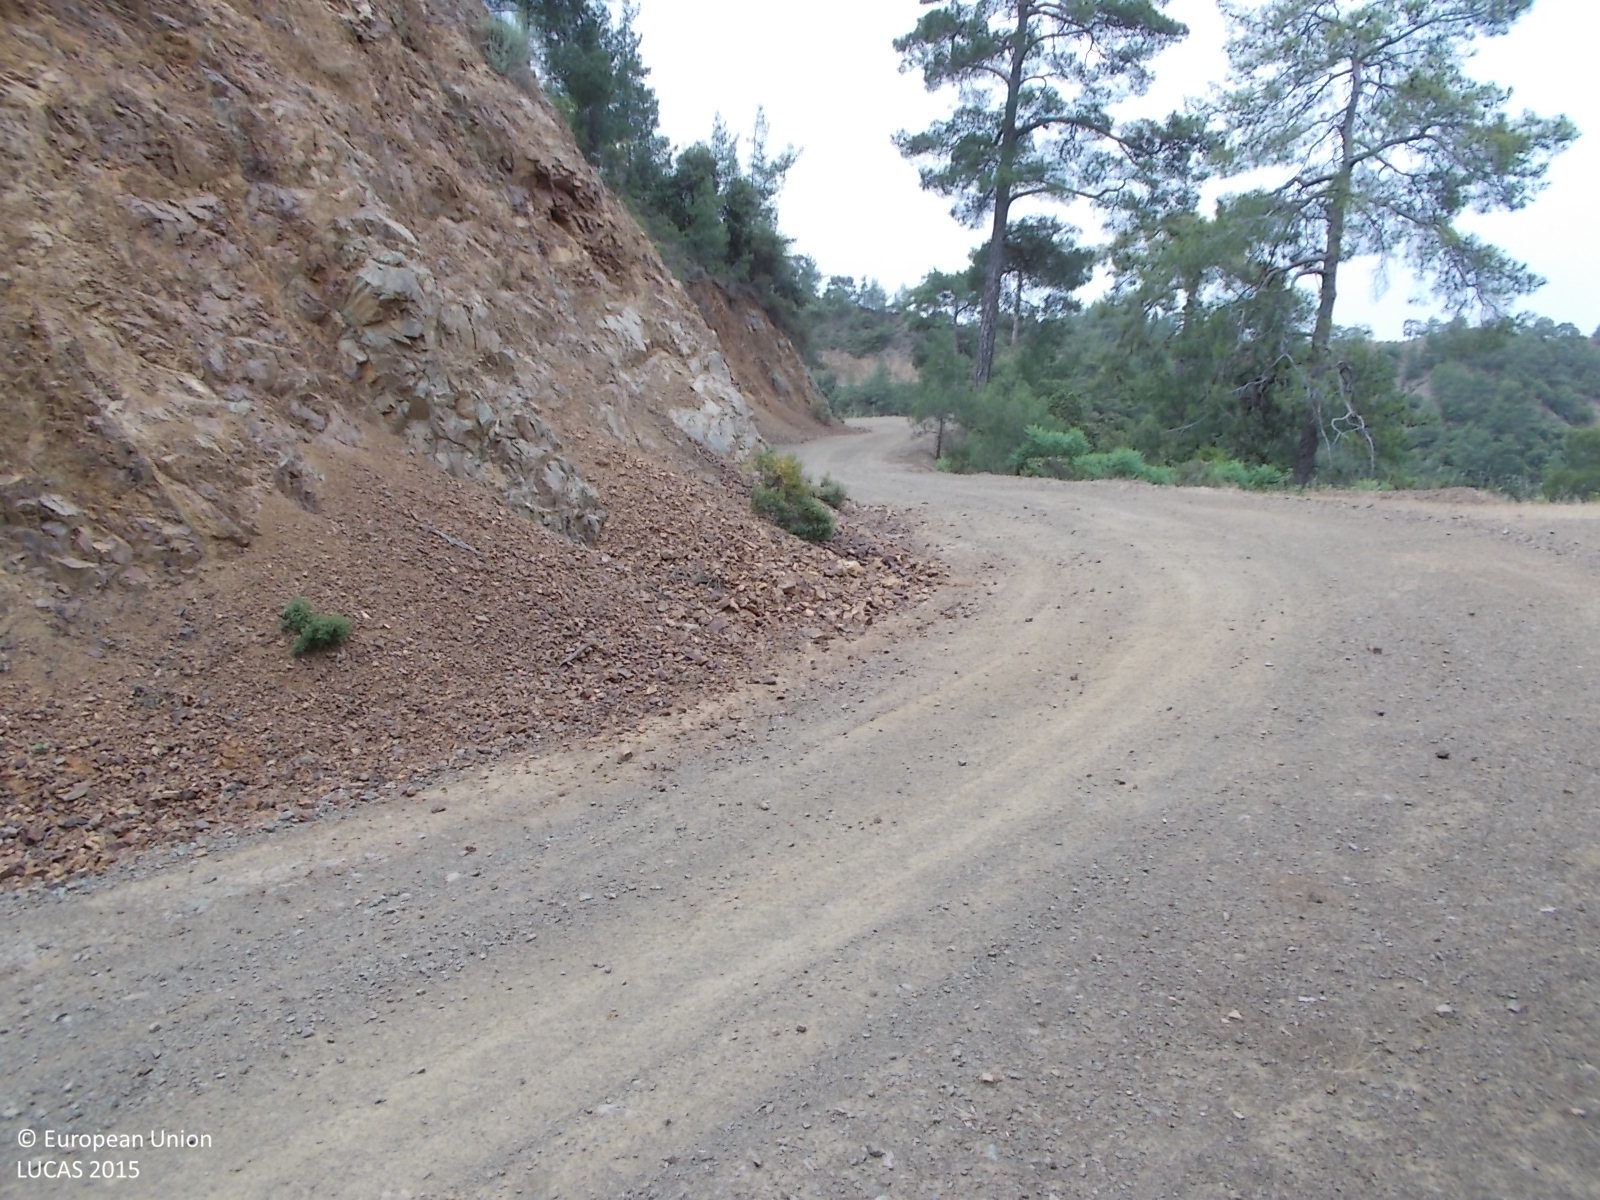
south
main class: Woodland
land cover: Broadleaved woodland
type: broadleaved evergreen forest
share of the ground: > 75 %
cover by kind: broadleaved forest trees 90 %, coniferous forest trees 10 %
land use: Forestry
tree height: > 5 m
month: May
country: CY
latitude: 34.9876
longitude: 32.6054
